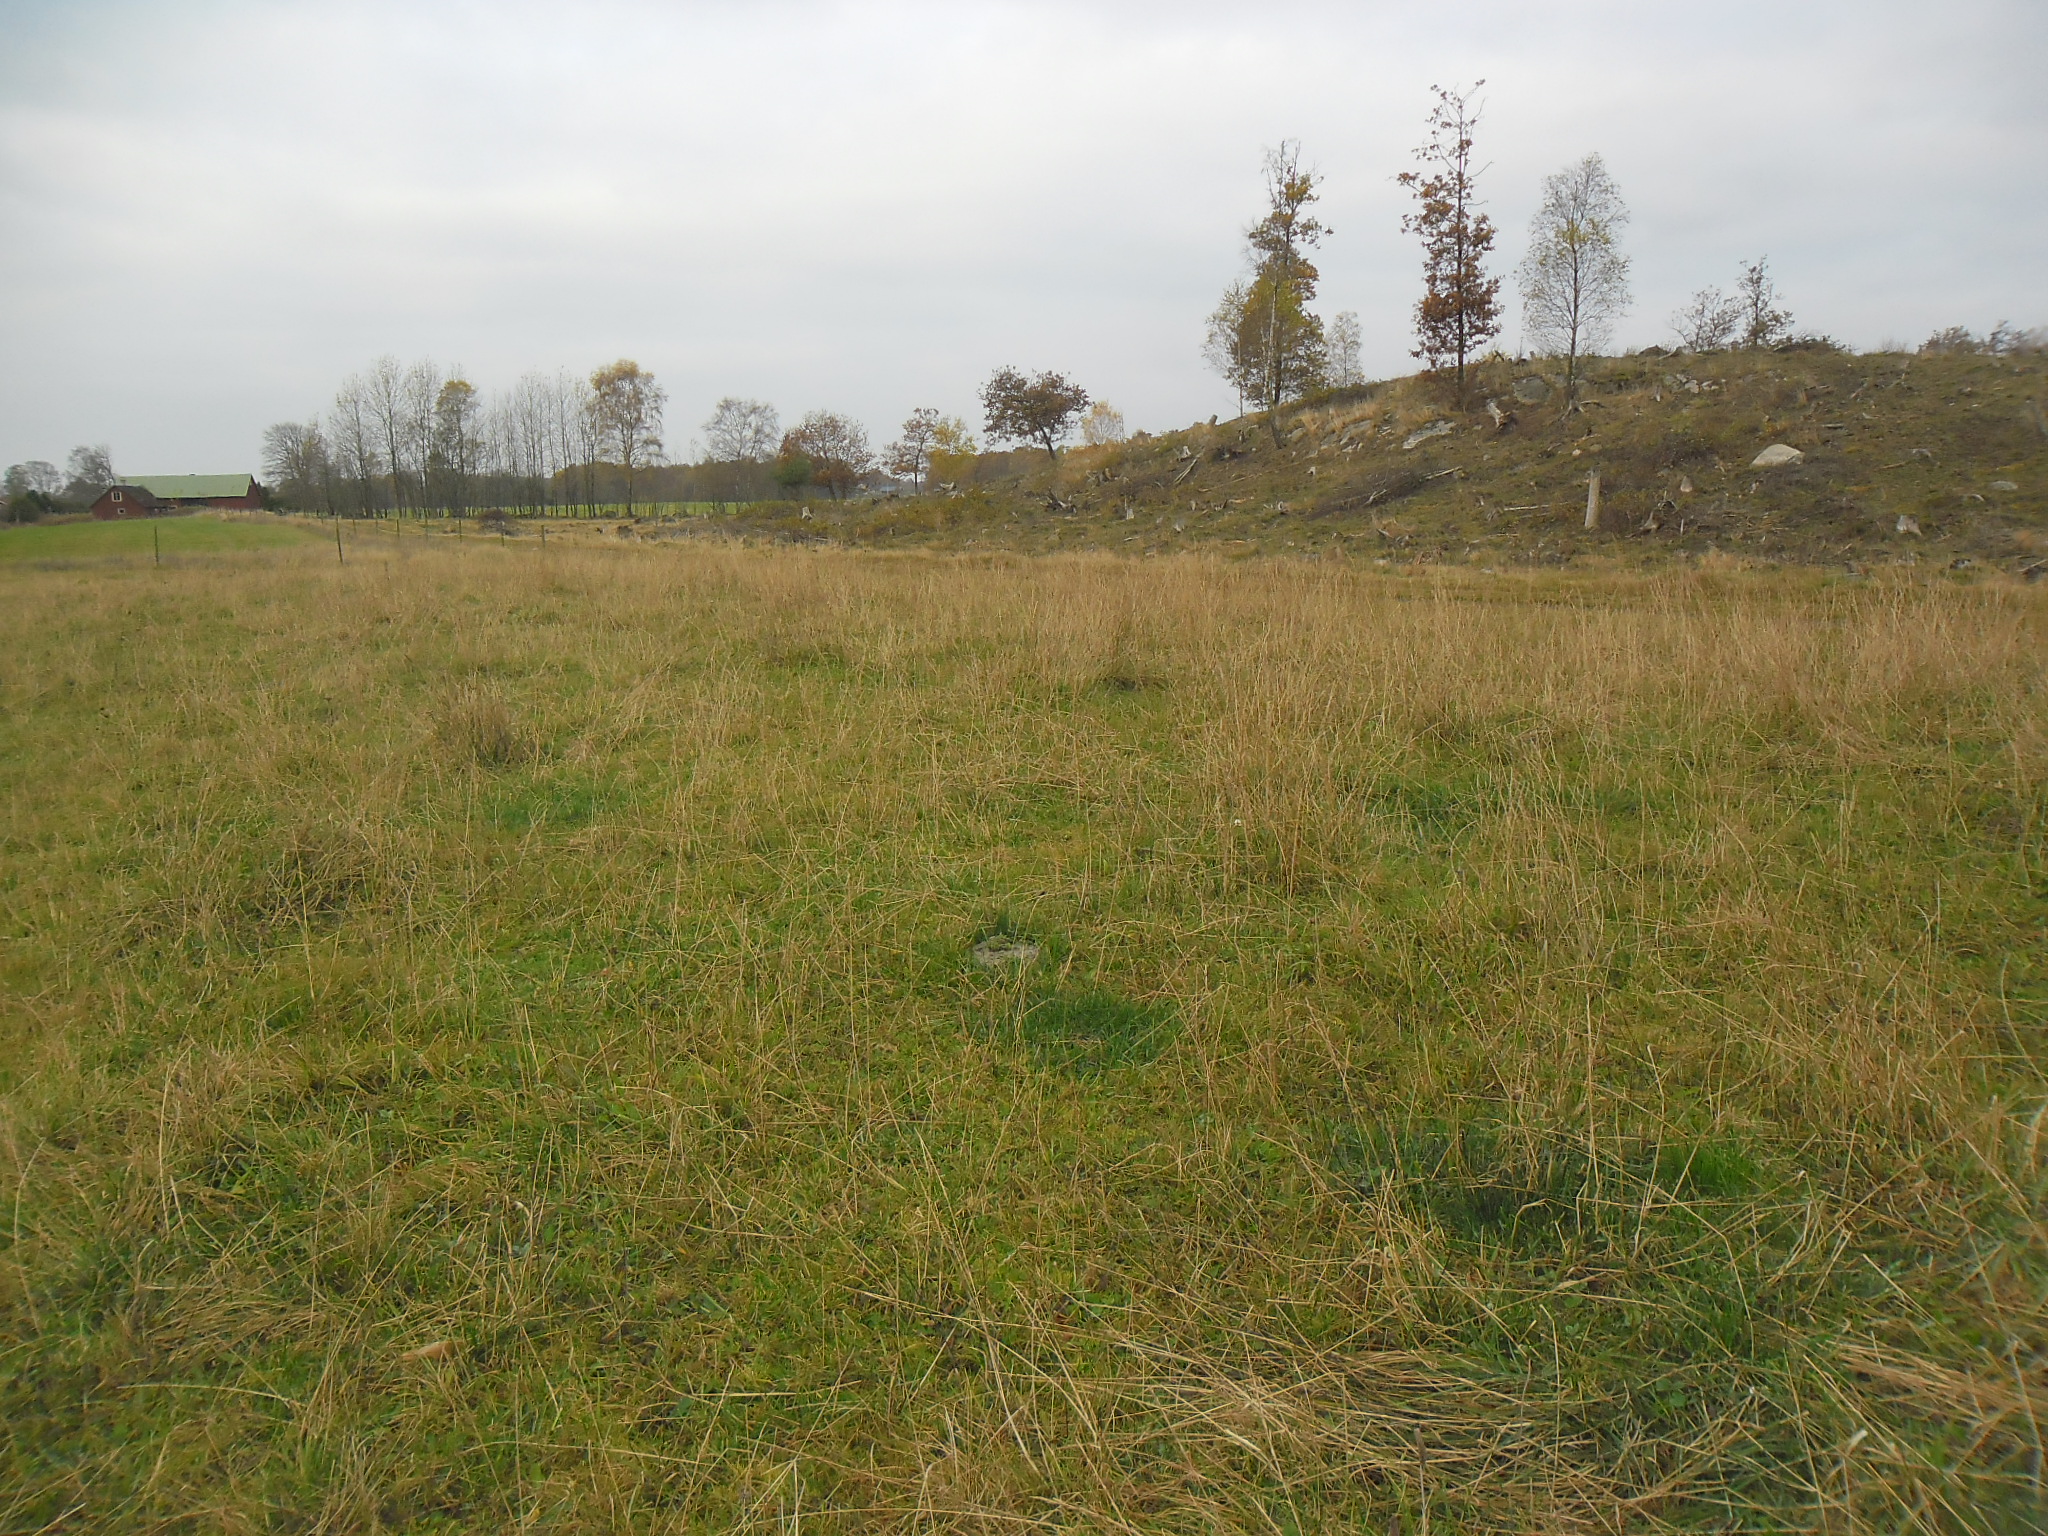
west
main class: Cropland
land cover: Temporary grasslands
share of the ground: > 75 %
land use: Agriculture (excluding fallow land and kitchen gardens)
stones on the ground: 25 - 50 %
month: October
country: SE
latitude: 56.5258
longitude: 13.1995
